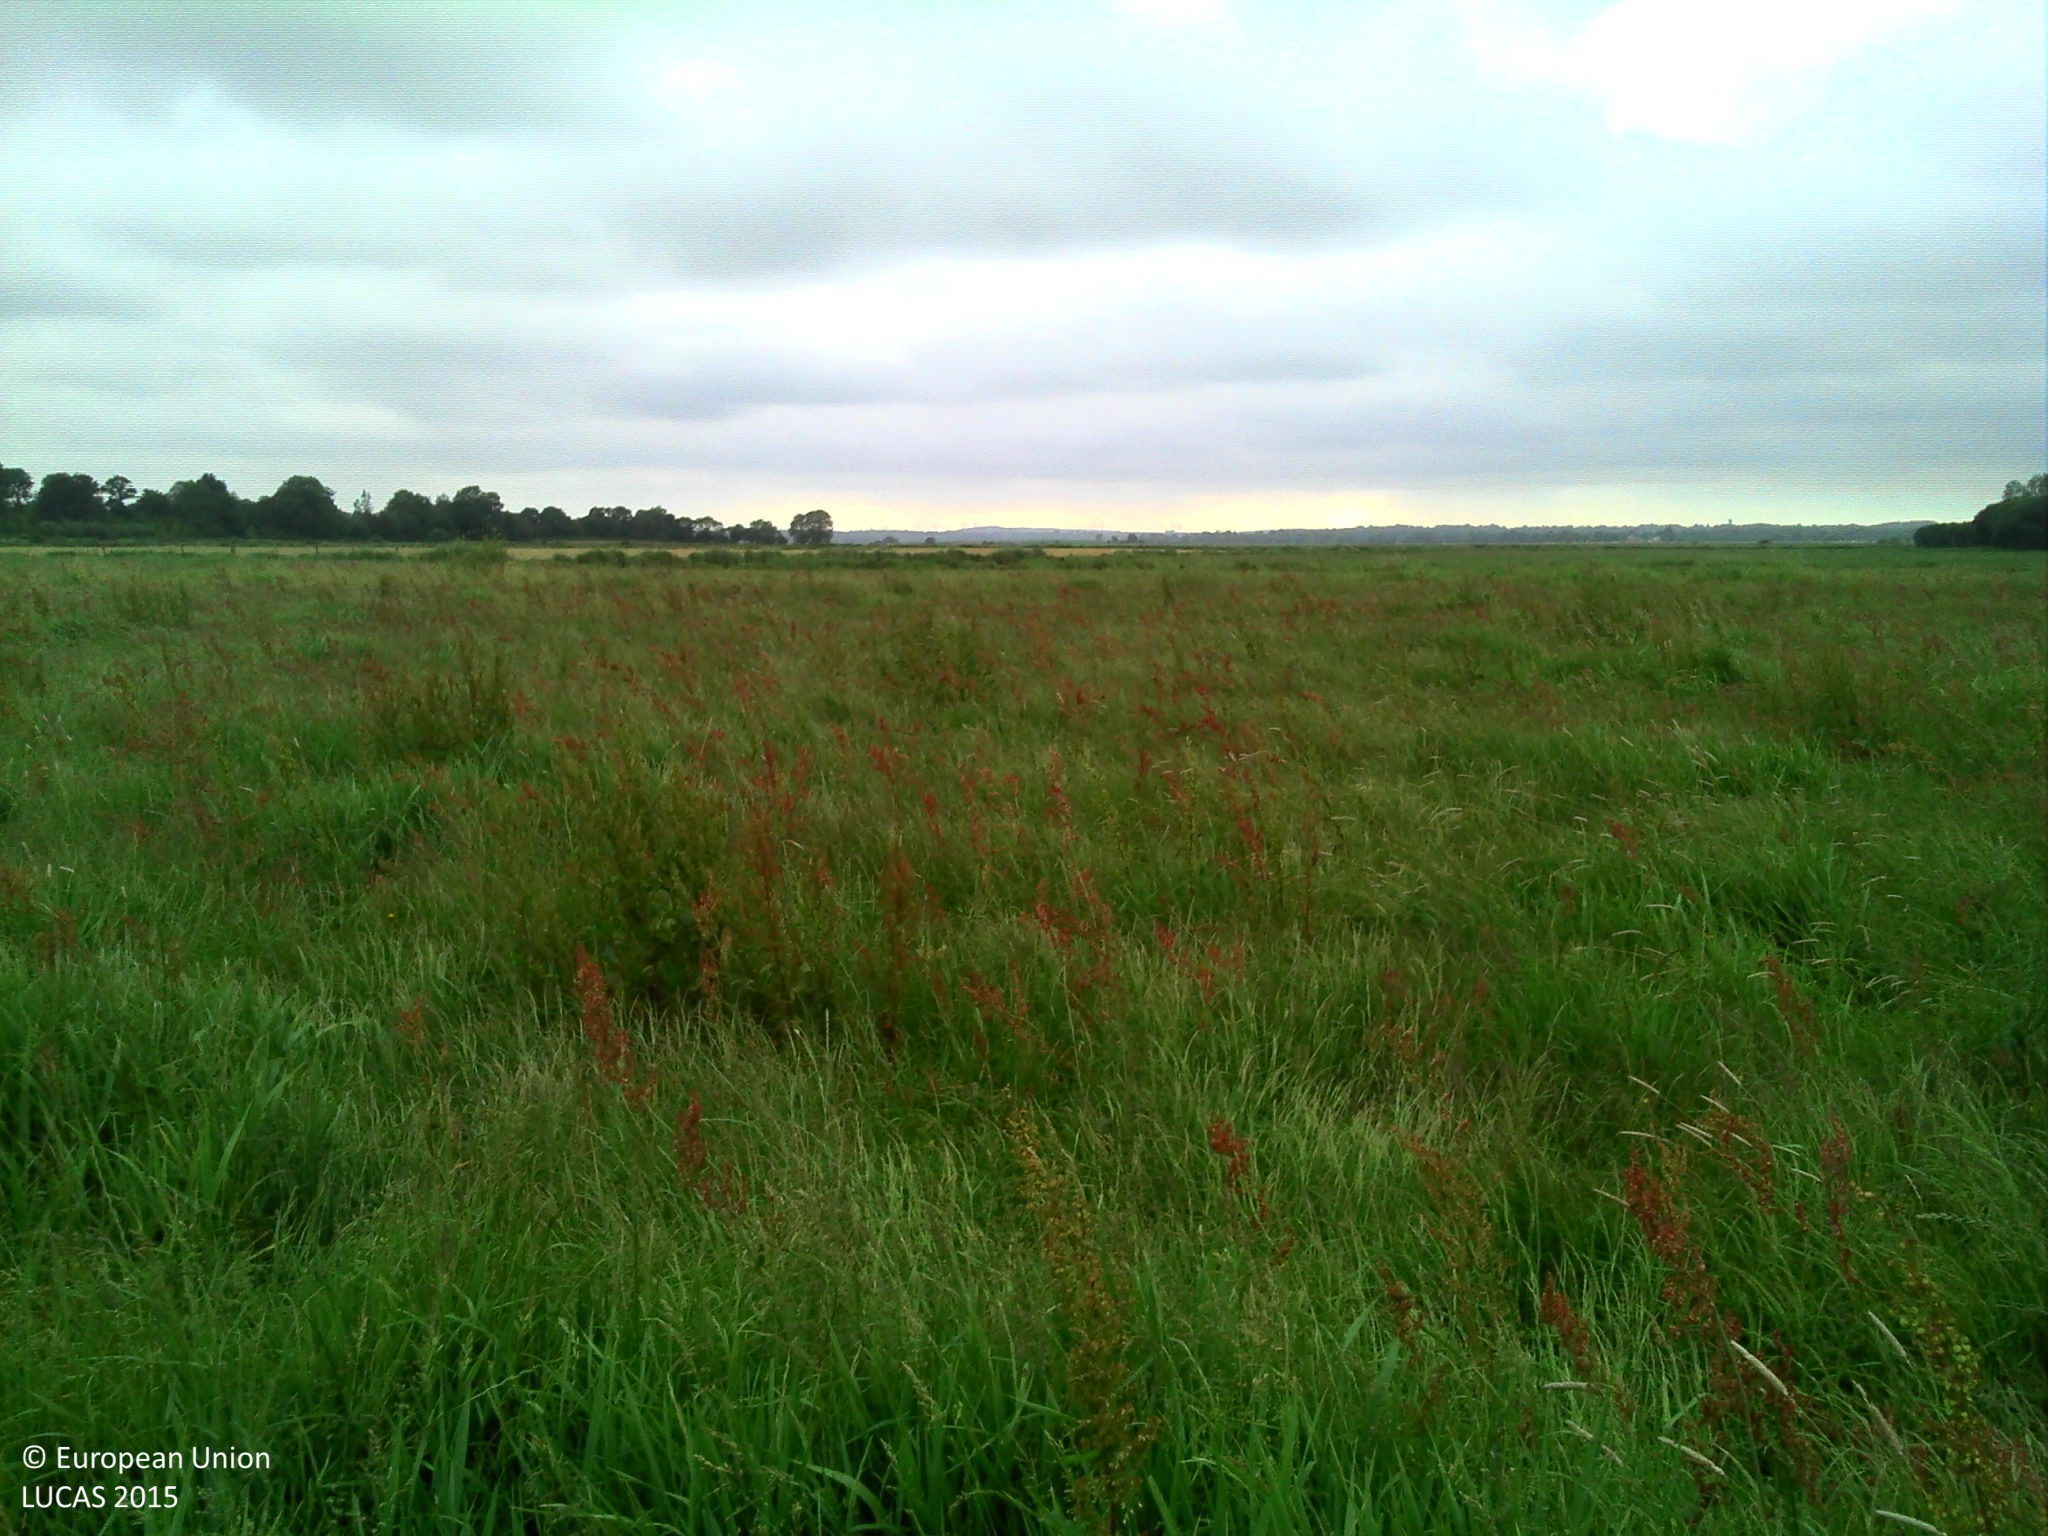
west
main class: Grassland
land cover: Grassland without tree/shrub cover
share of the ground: > 75 %
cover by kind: herbaceous plants 100 %
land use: Agriculture (excluding fallow land and kitchen gardens)
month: June
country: FR
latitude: 49.3704
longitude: -1.4374
